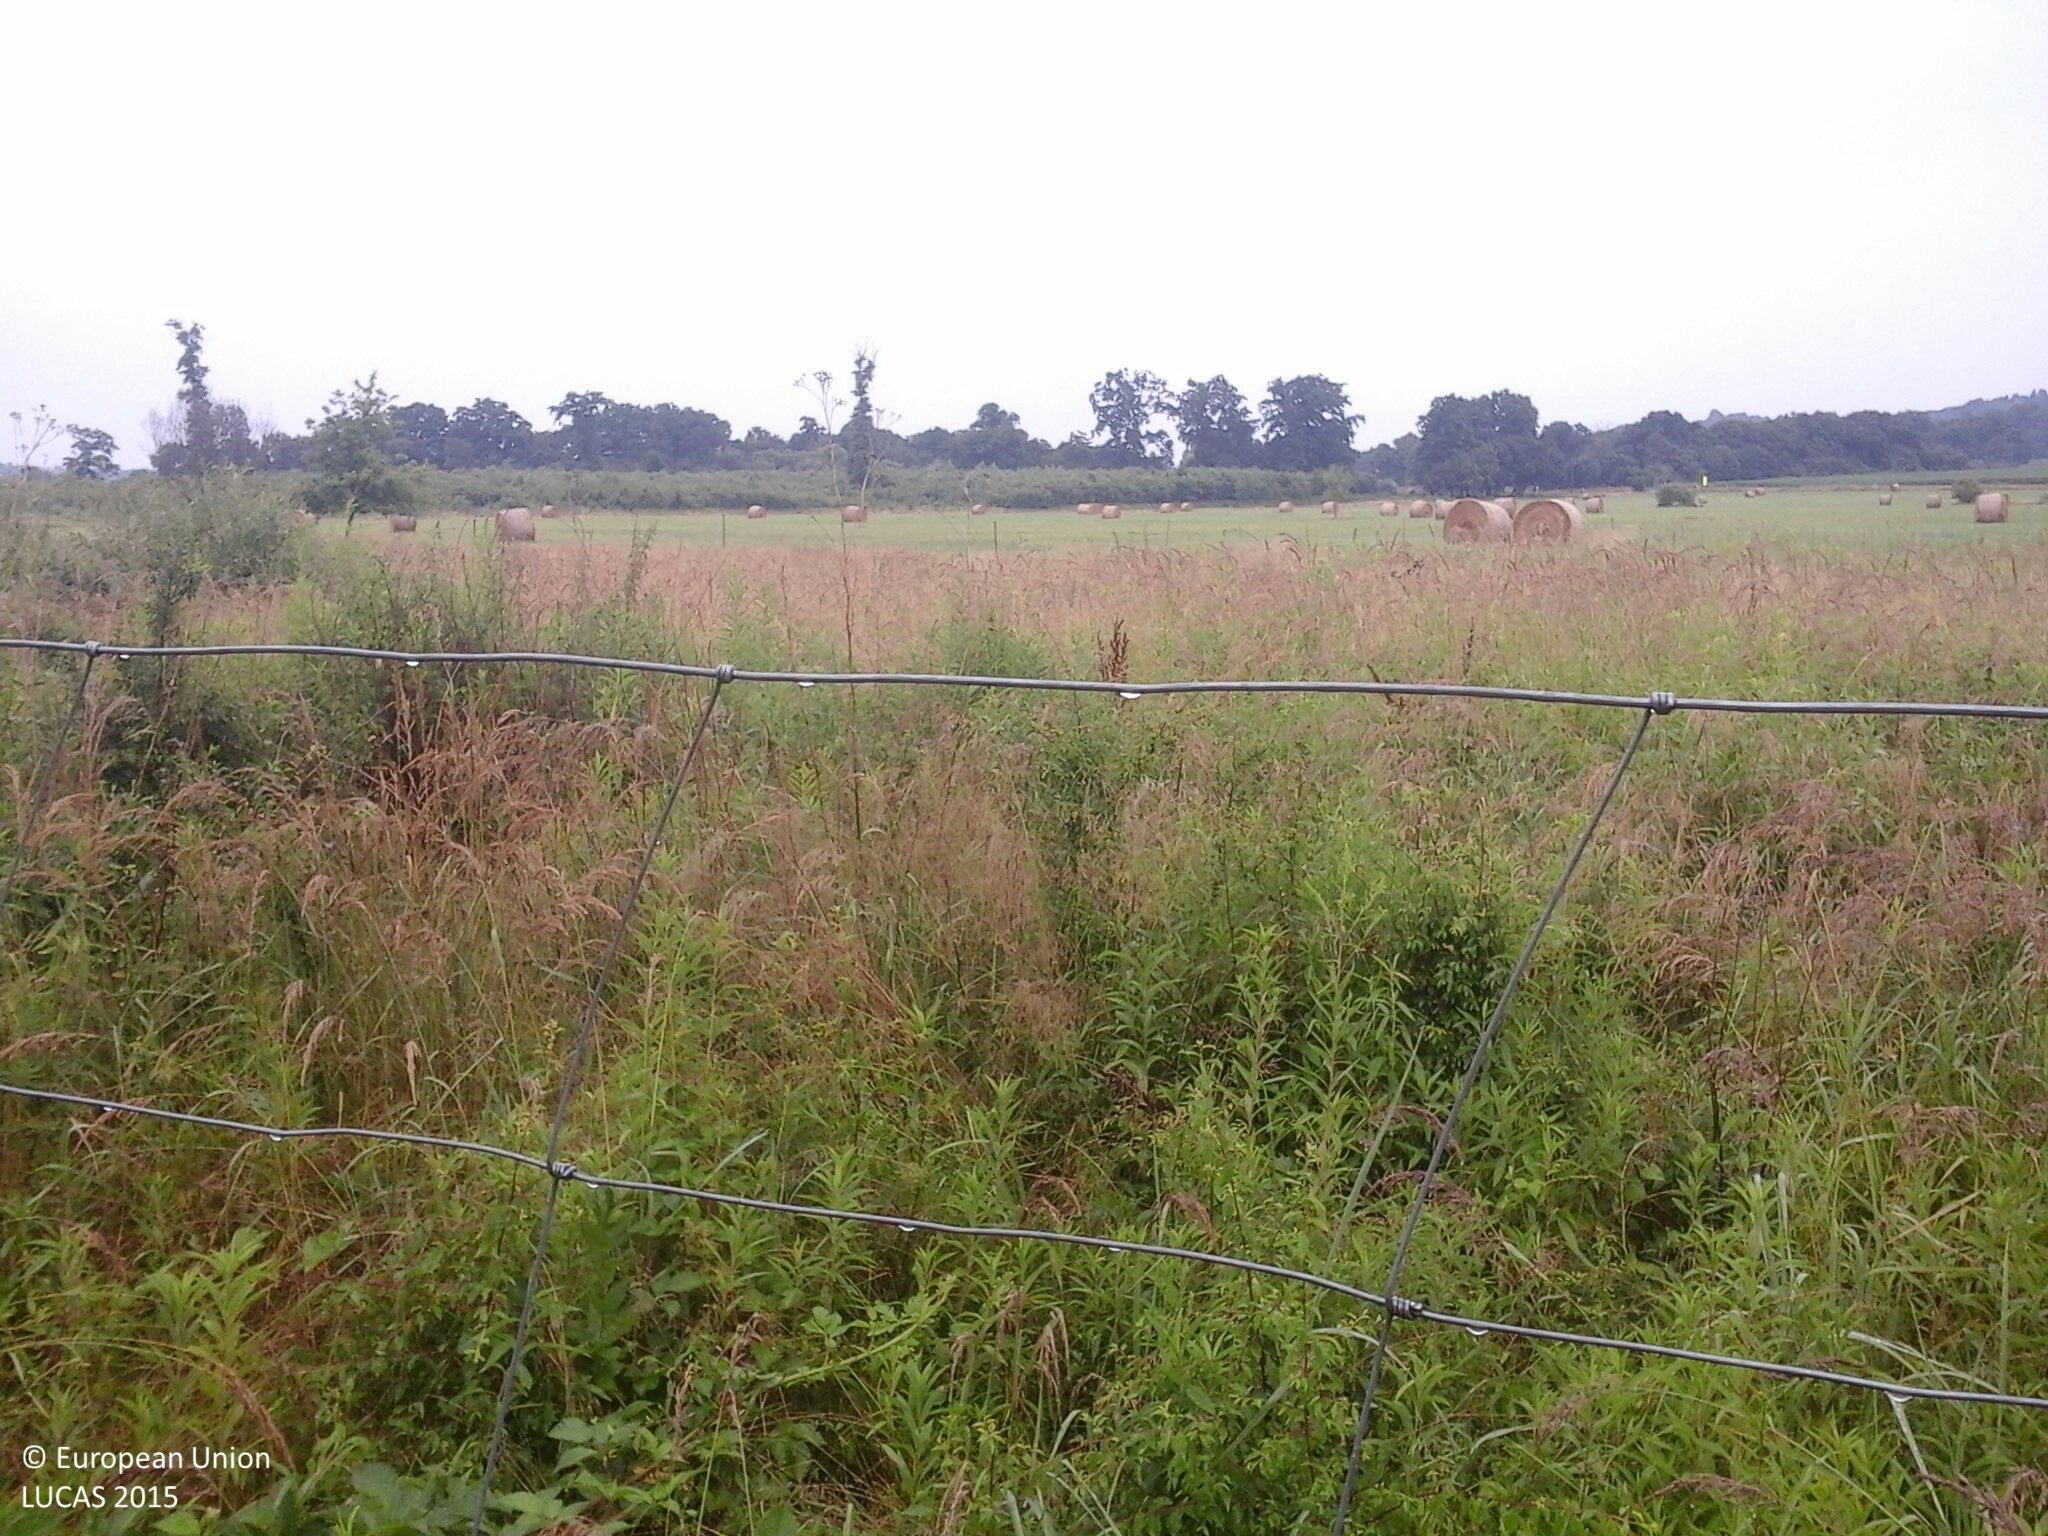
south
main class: Grassland
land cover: Grassland without tree/shrub cover
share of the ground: > 75 %
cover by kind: herbaceous plants 100 %
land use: Agriculture (excluding fallow land and kitchen gardens)
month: July
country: HU
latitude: 46.6010
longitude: 16.5680
